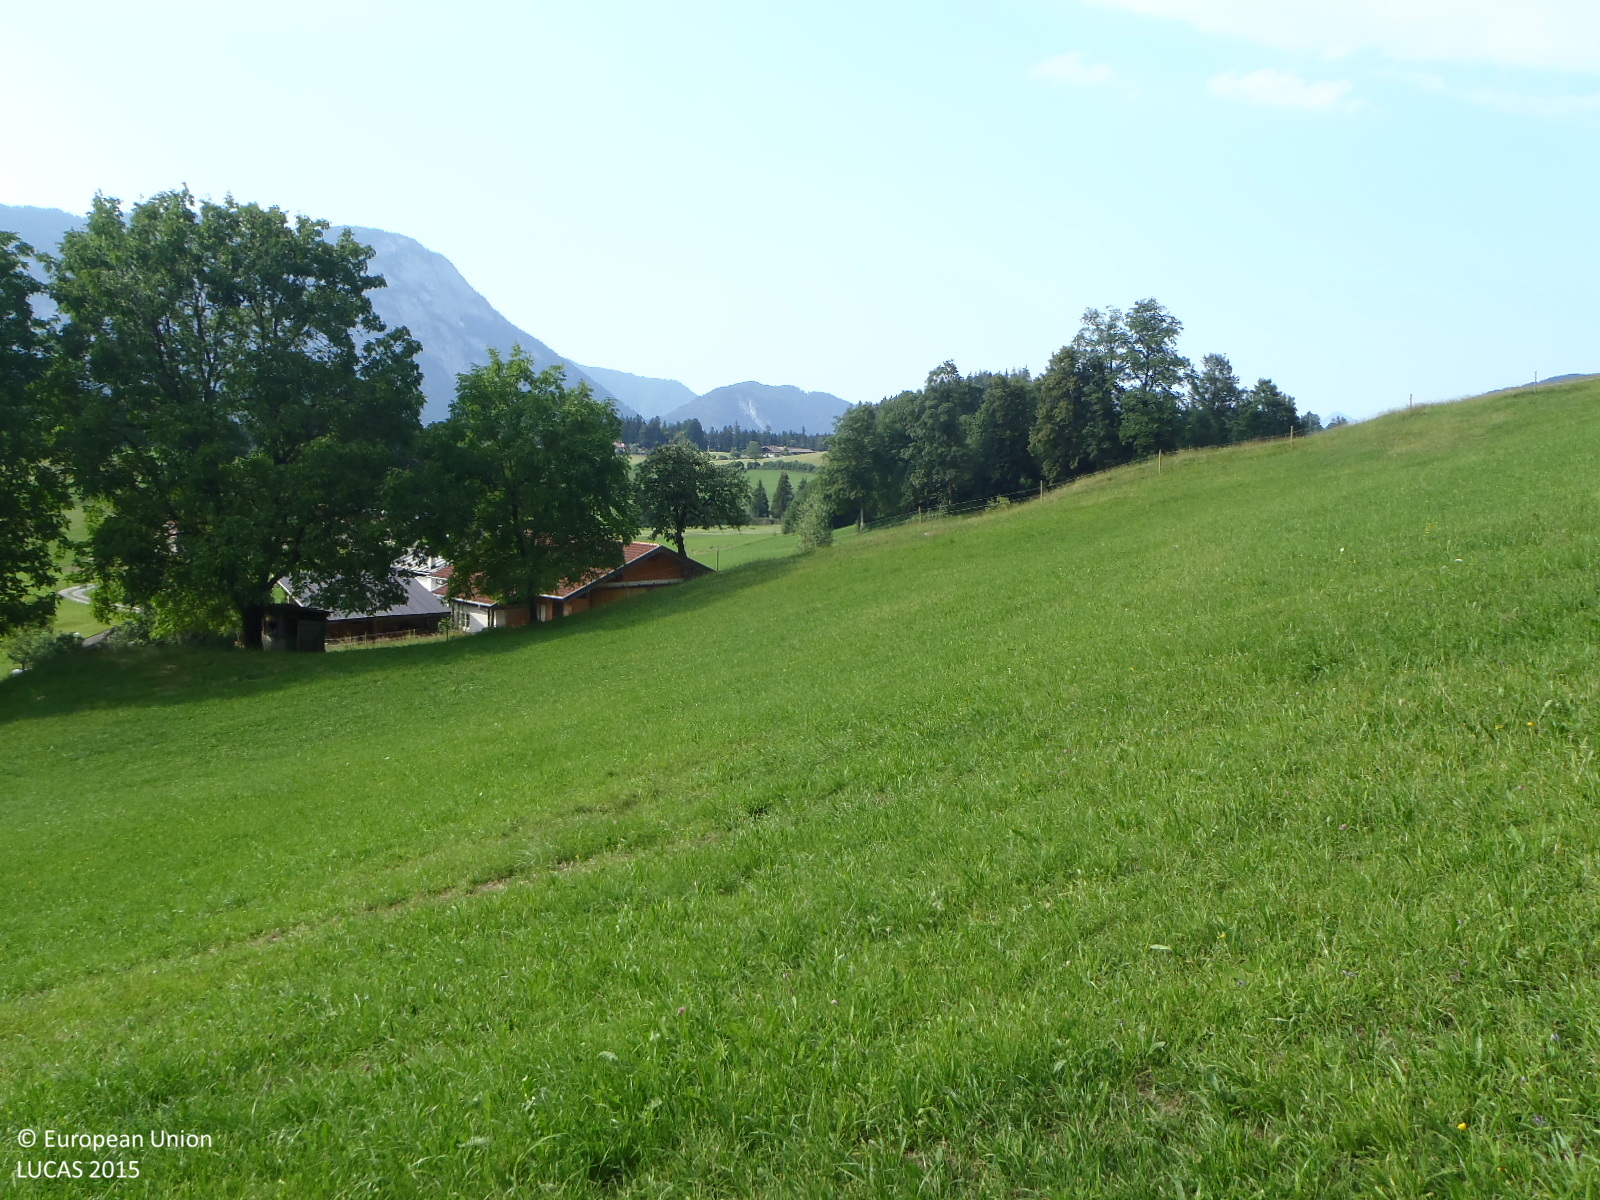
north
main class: Grassland
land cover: Grassland without tree/shrub cover
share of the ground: > 75 %
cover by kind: herbaceous plants 100 %
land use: Agriculture (excluding fallow land and kitchen gardens)
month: July
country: AT
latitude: 47.5187
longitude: 12.1365
